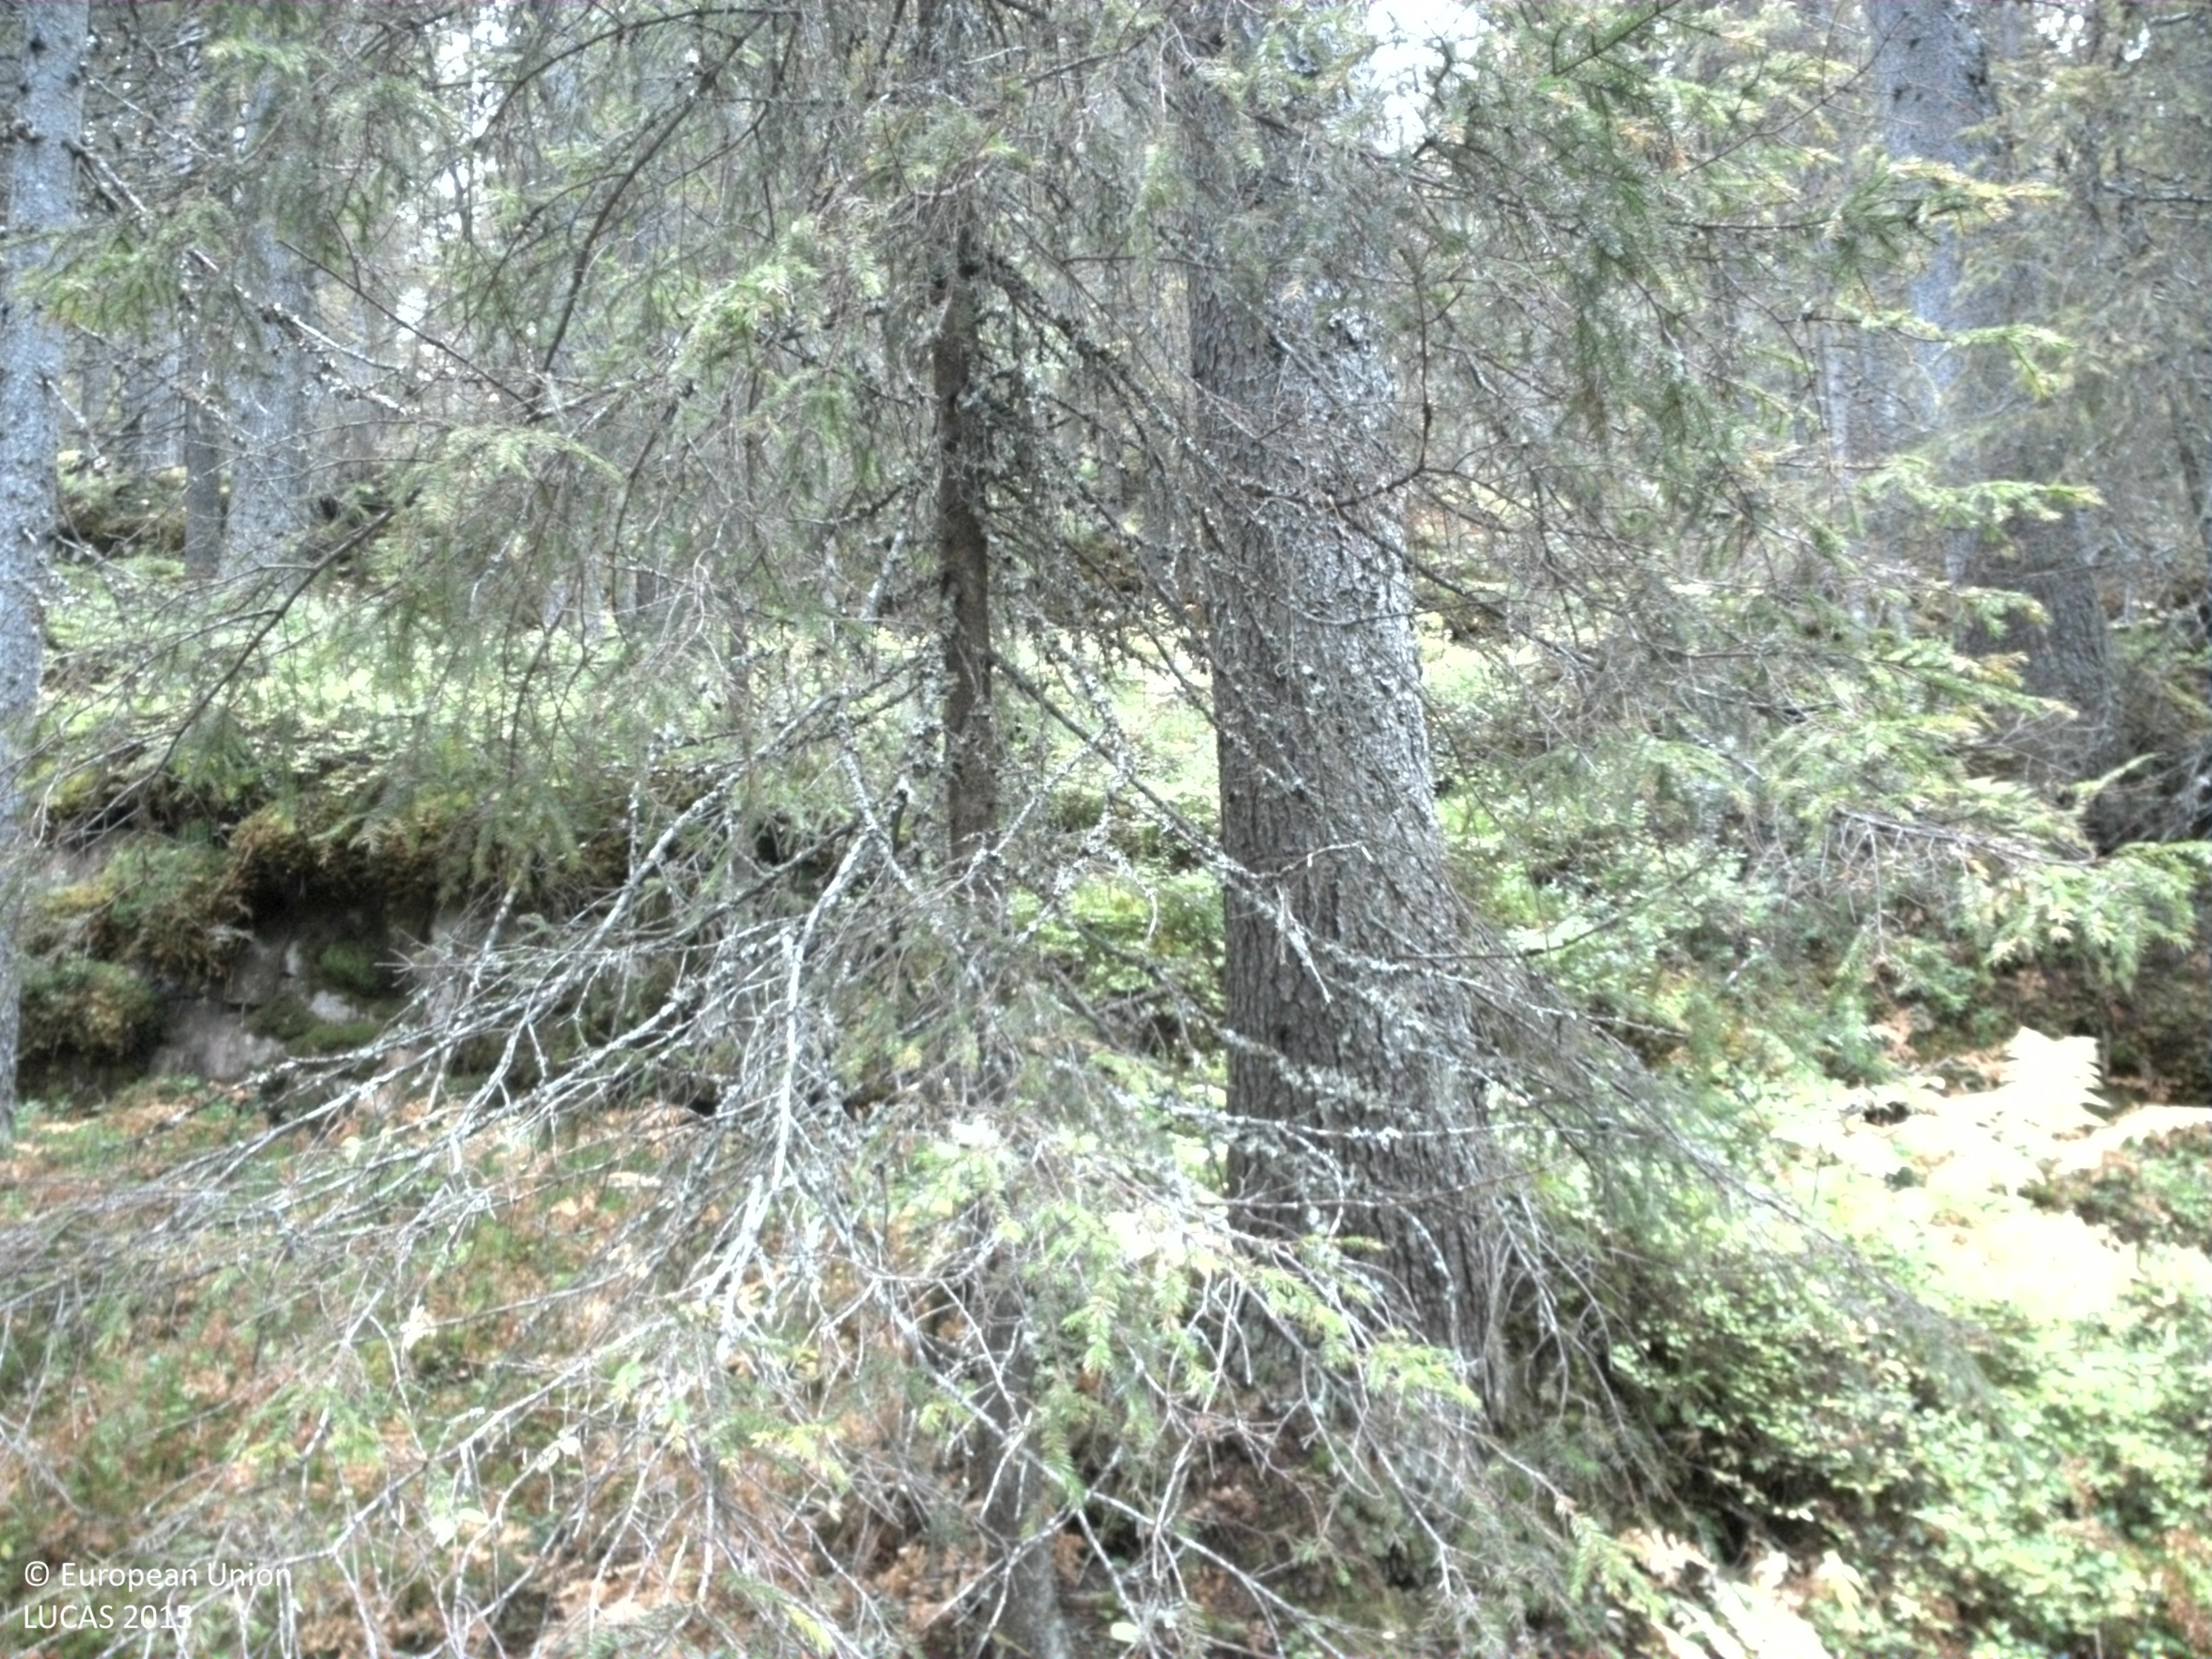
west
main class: Woodland
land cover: Spruce dominated coniferous woodland
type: boreal forest
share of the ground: 50 - 75 %
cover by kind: coniferous forest trees 60 %, shrubs 15 %, herbaceous plants 15 %, lichens and mosses 10 %
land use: Forestry
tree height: > 5 m
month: September
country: SE
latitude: 64.8784
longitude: 17.7966
